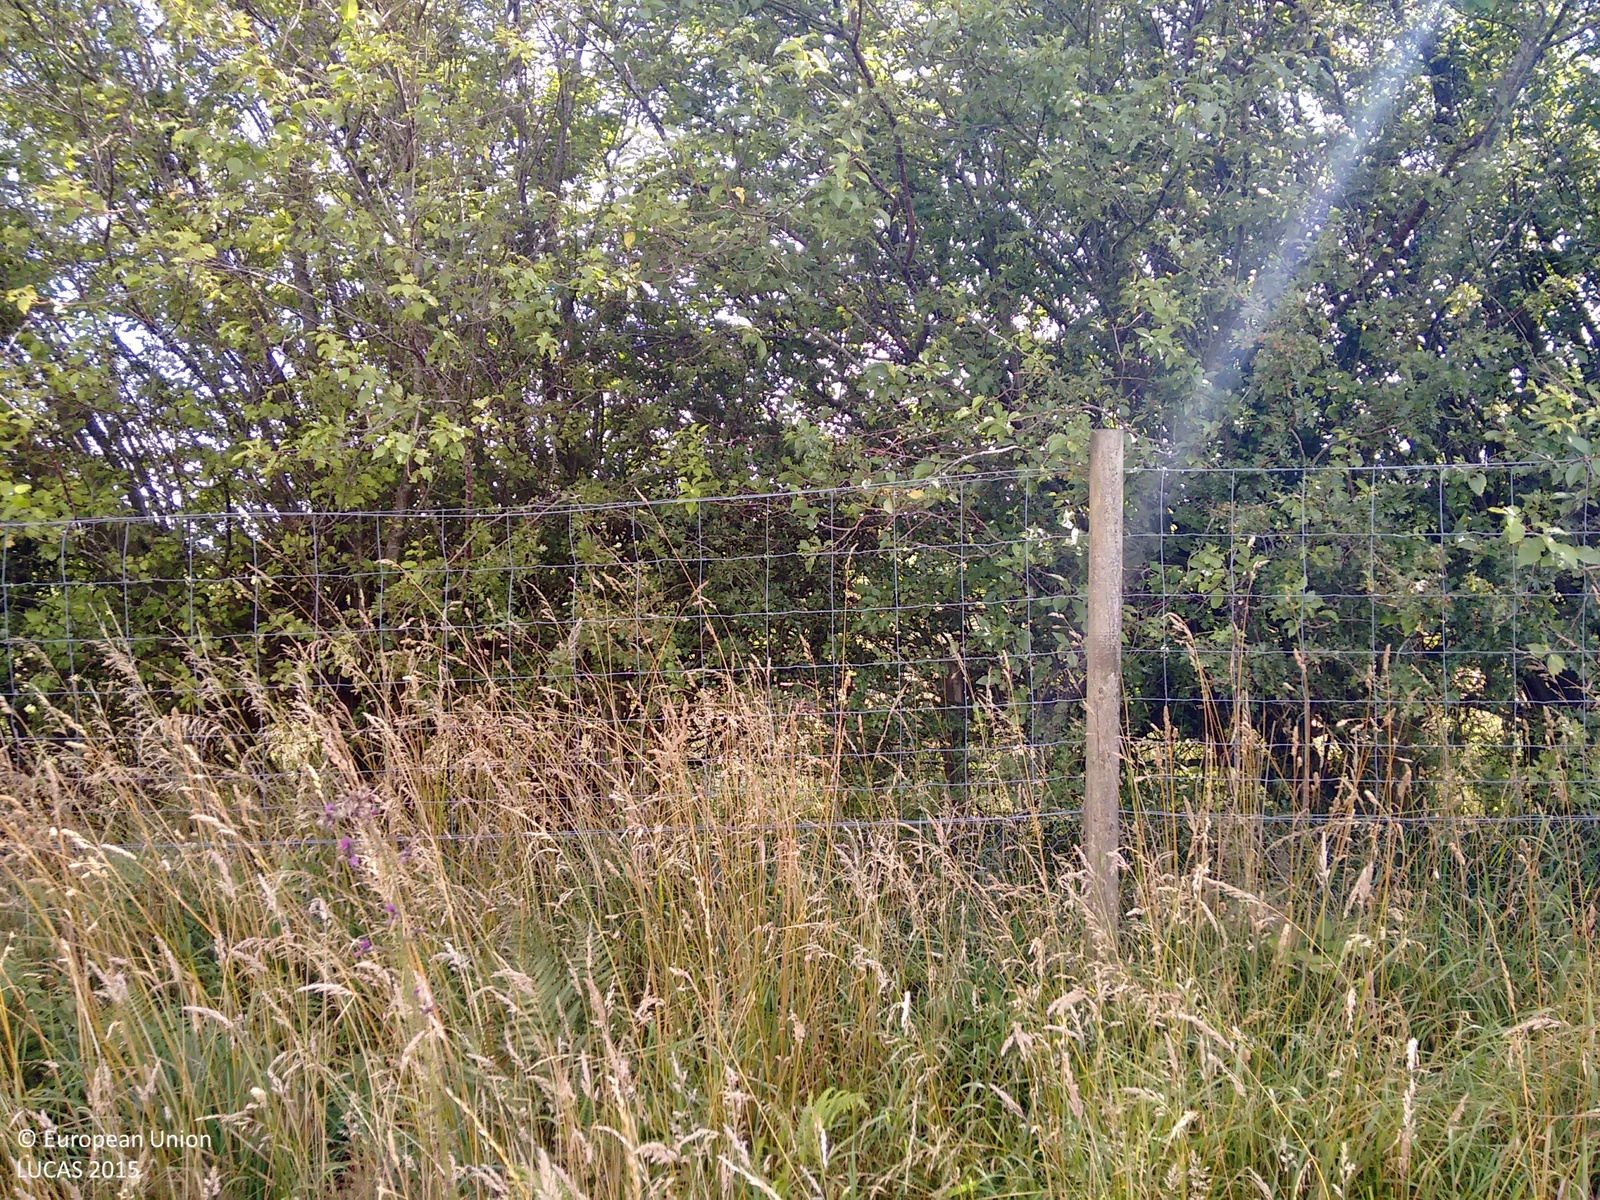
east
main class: Grassland
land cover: Grassland with sparse tree/shrub cover
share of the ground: > 75 %
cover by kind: herbaceous plants 85 %, shrubs 10 %, broadleaved forest trees 5 %
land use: Semi-natural and natural areas not in use
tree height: < 5 m
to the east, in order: Grassland with sparse tree/shrub cover; Fences; Lines of trees; Spontaneously vegetated surfaces; Broadleaved woodland; Spontaneously vegetated surfaces; Spruce dominated coniferous woodland; Broadleaved woodland; Grassland without tree/shrub cover; Electric lines; Broadleaved woodland; Grass margins; Paved roads, cycling and walking lanes; Grass margins; Spontaneously vegetated surfaces; Abandoned hedges; Fences; Grassland without tree/shrub cover
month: August
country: GB
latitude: 55.0712
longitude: -2.9591
